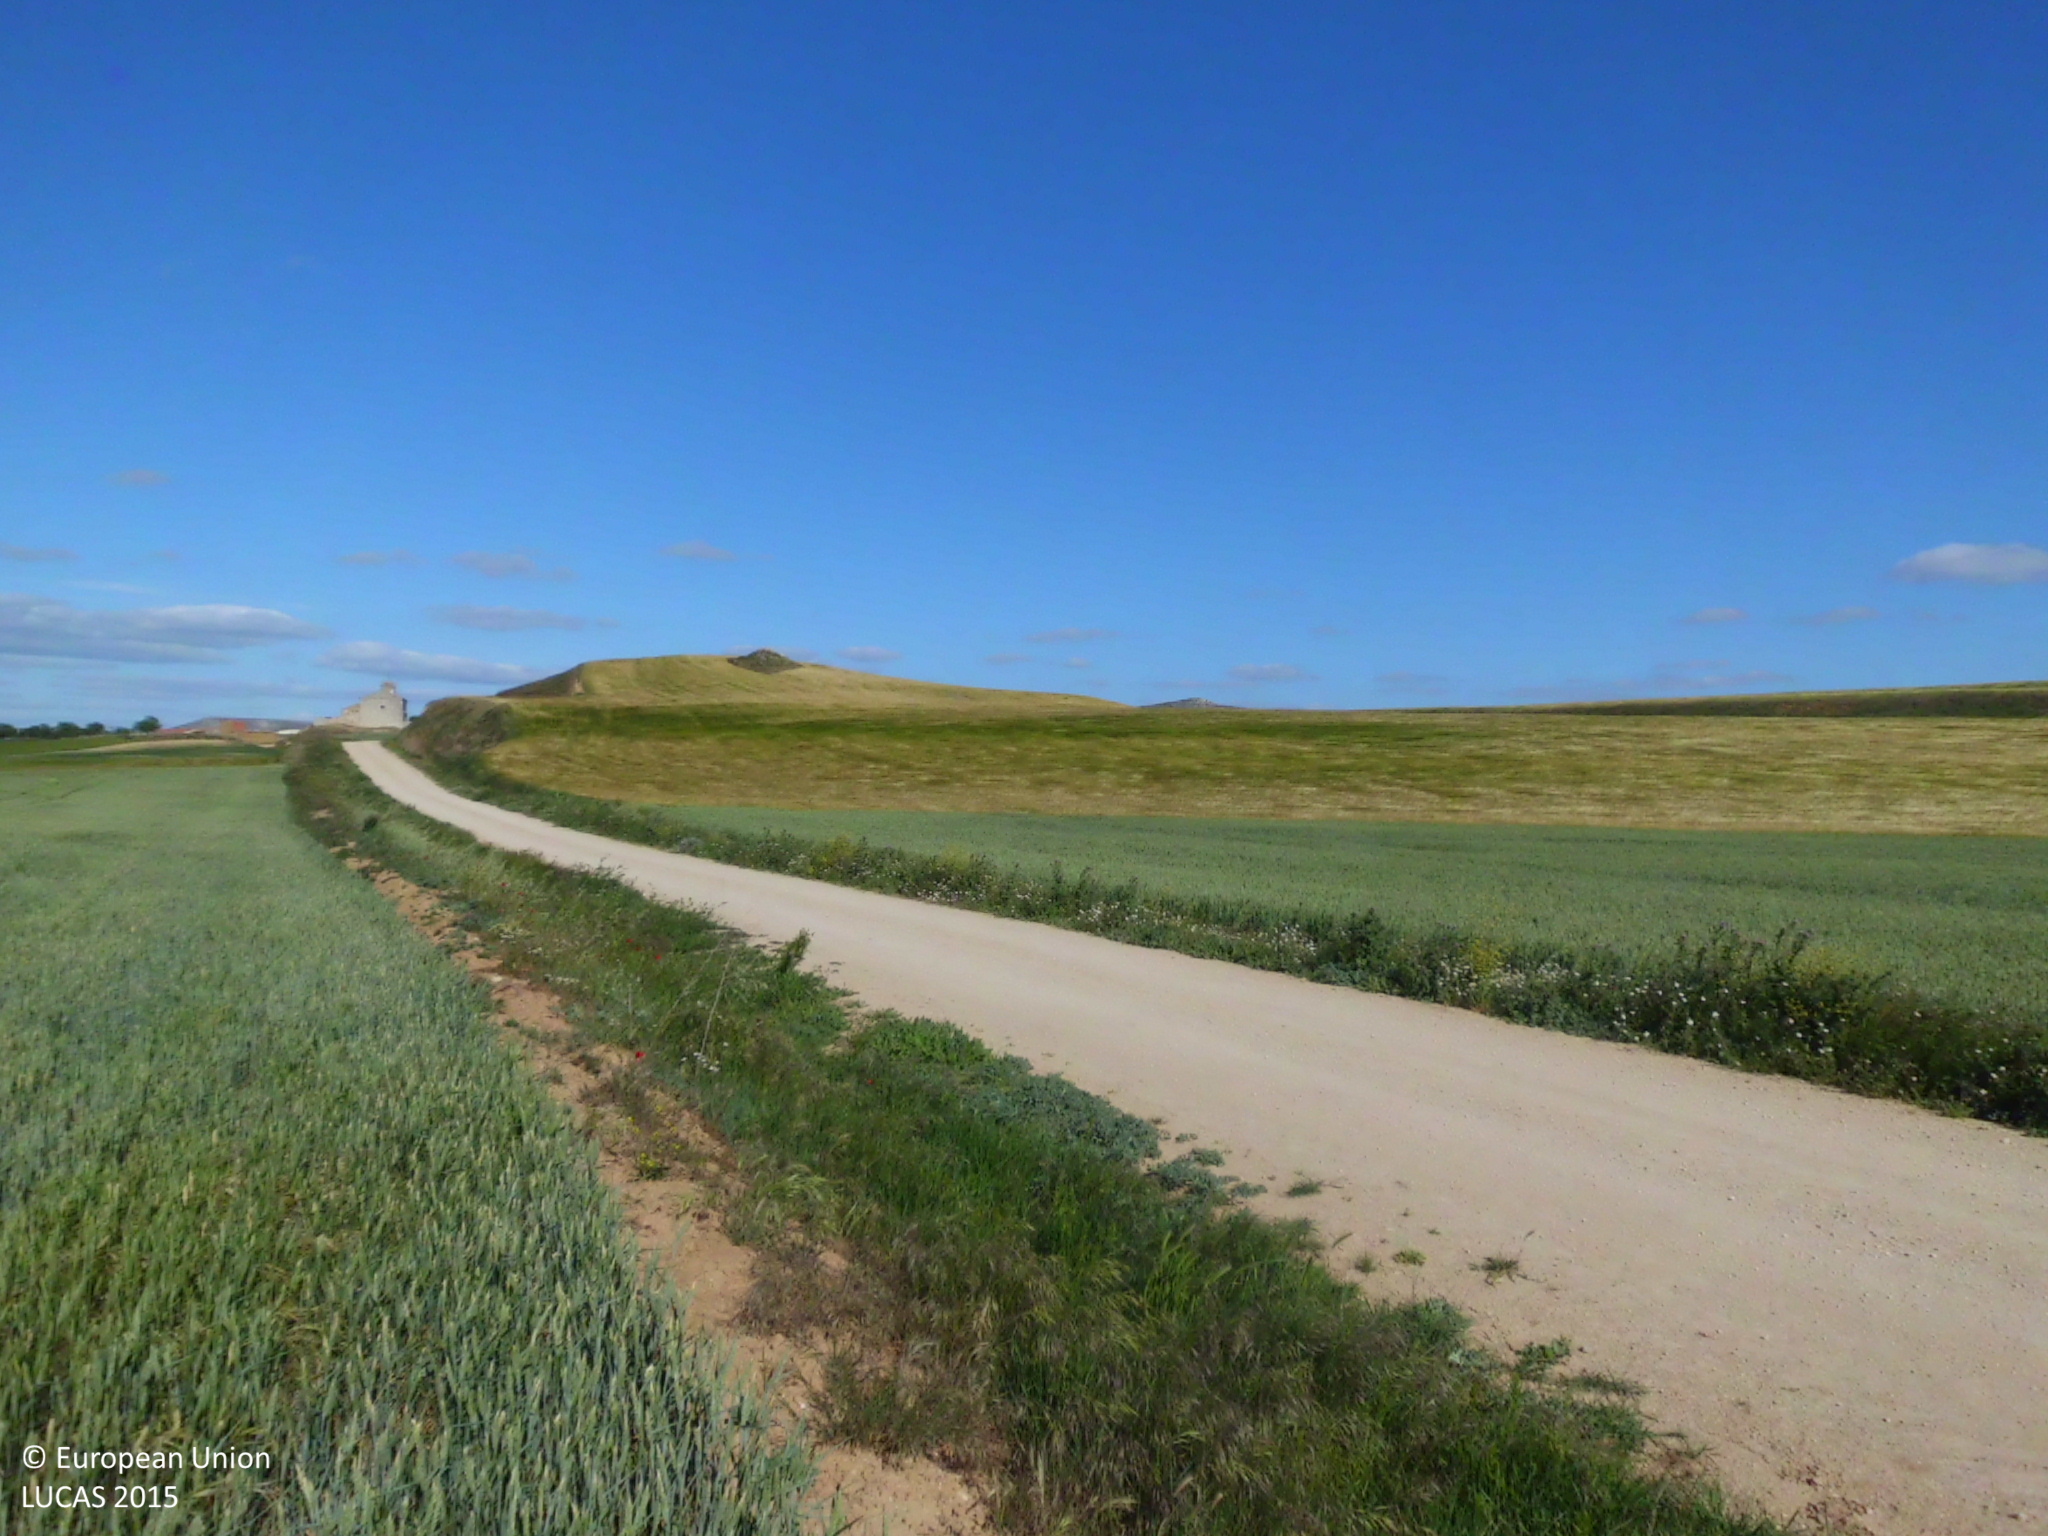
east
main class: Cropland
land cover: Common wheat
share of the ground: > 75 %
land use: Agriculture (excluding fallow land and kitchen gardens)
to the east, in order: Common wheat; Grass margins; Tracks; Grass margins; Barley; Grassland without tree/shrub cover; Barley
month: May
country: ES
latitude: 42.2747
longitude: -4.1687
